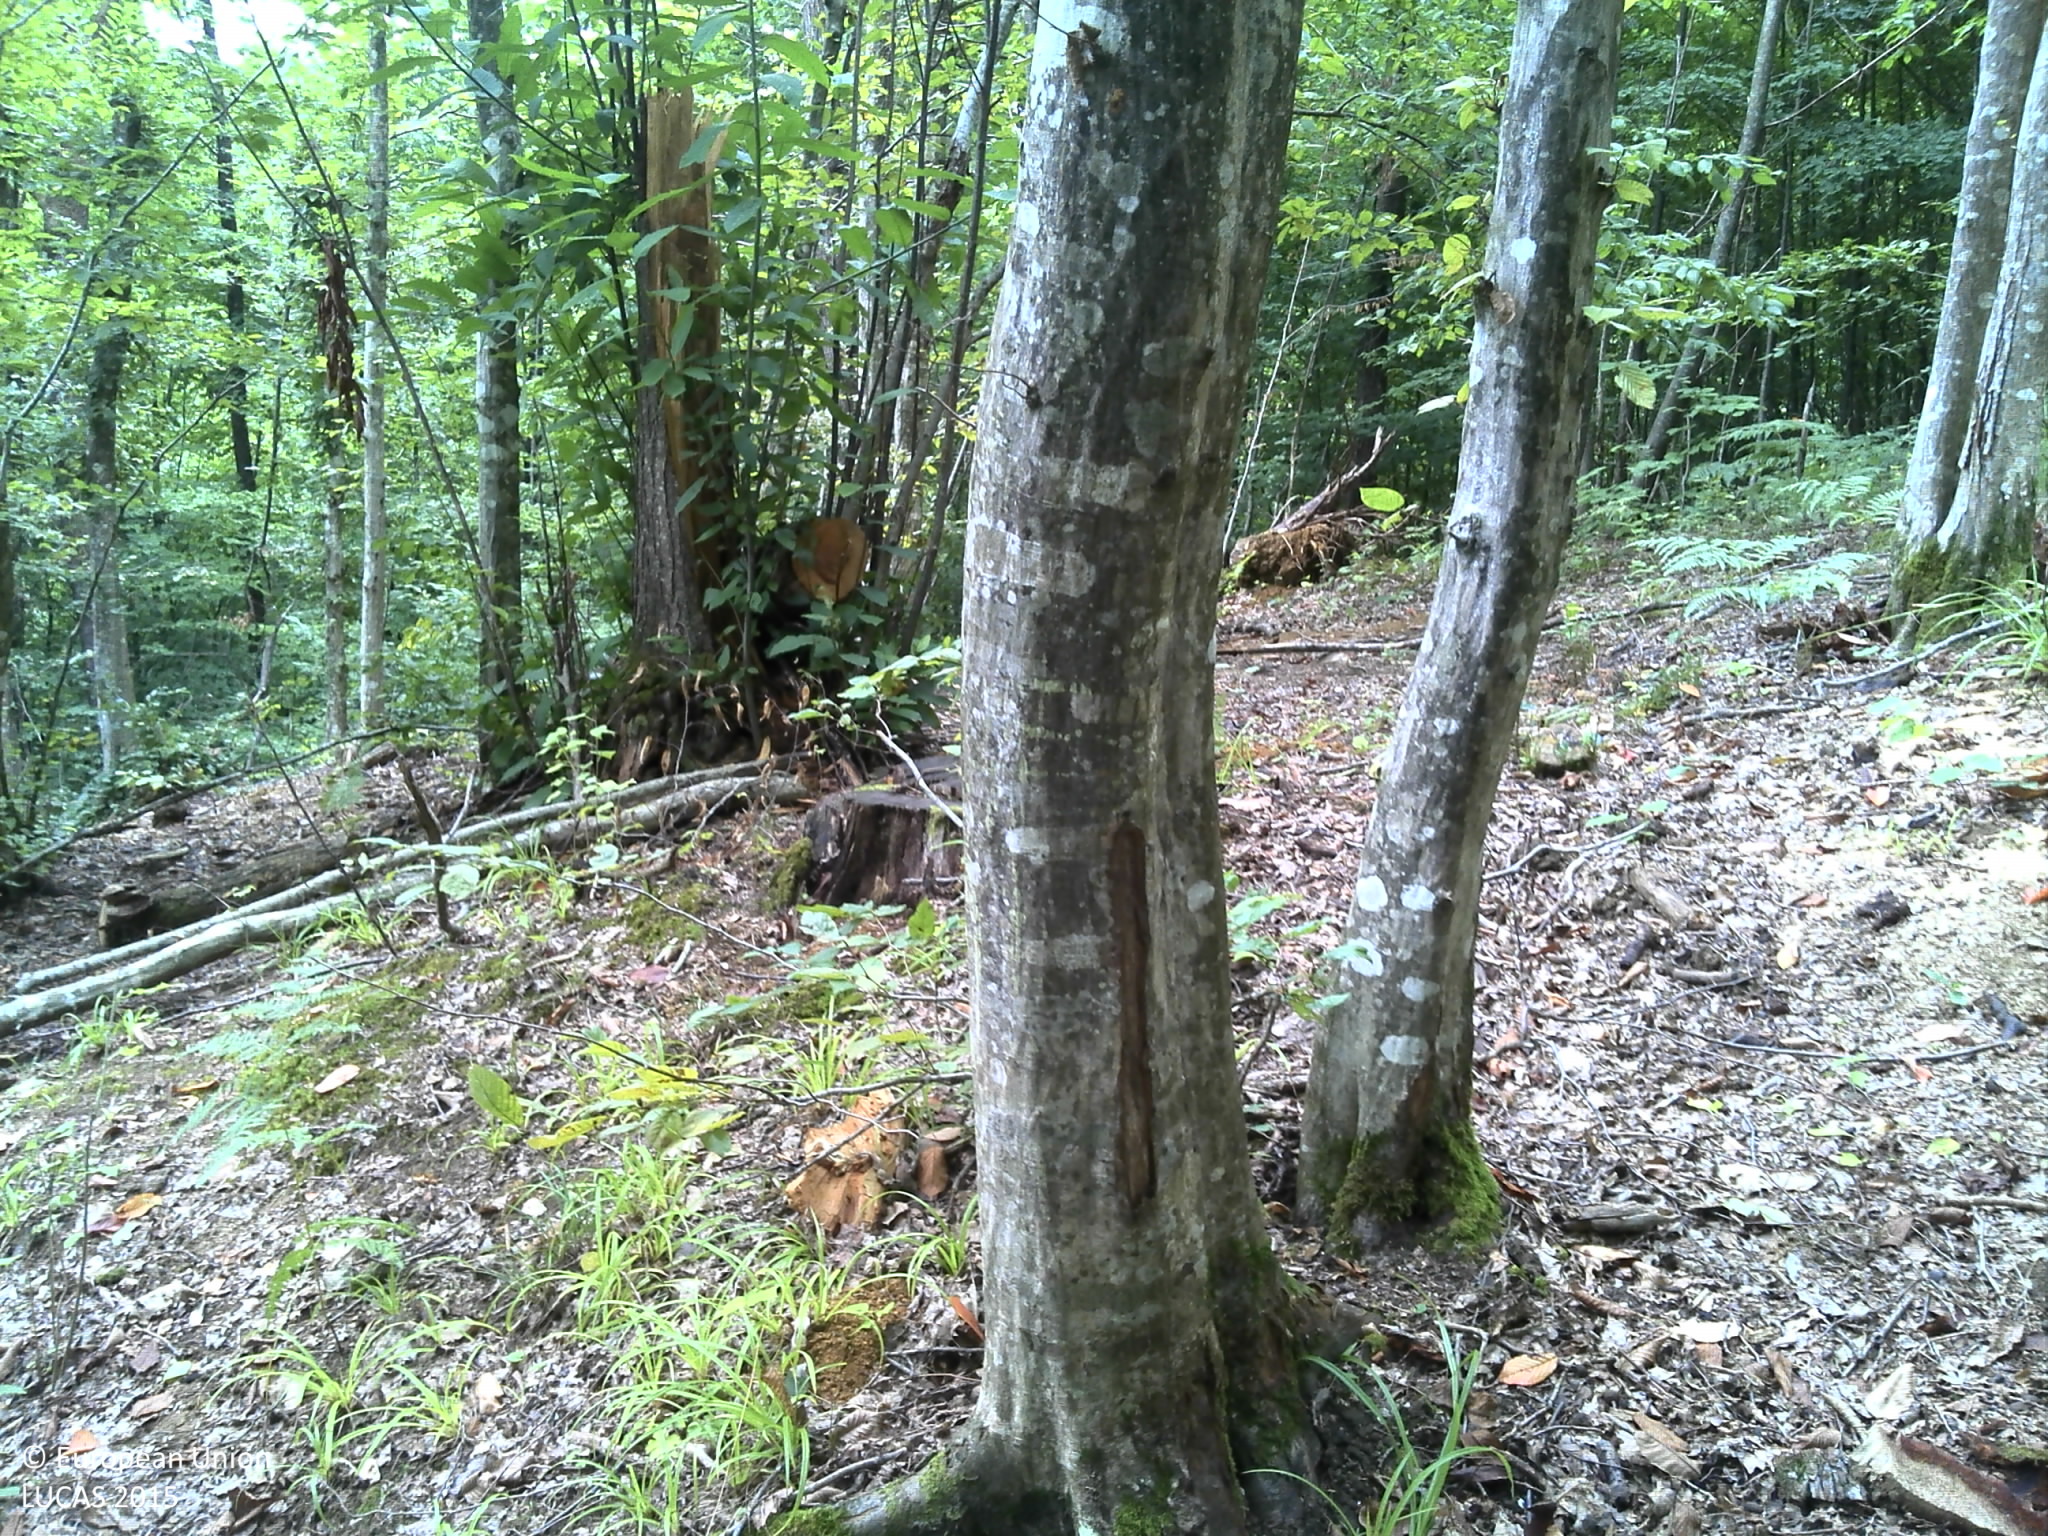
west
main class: Woodland
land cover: Broadleaved woodland
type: beech forest
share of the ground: > 75 %
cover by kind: broadleaved forest trees 100 %
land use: Forestry
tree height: > 5 m
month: August
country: HR
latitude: 45.2916
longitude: 16.1042
